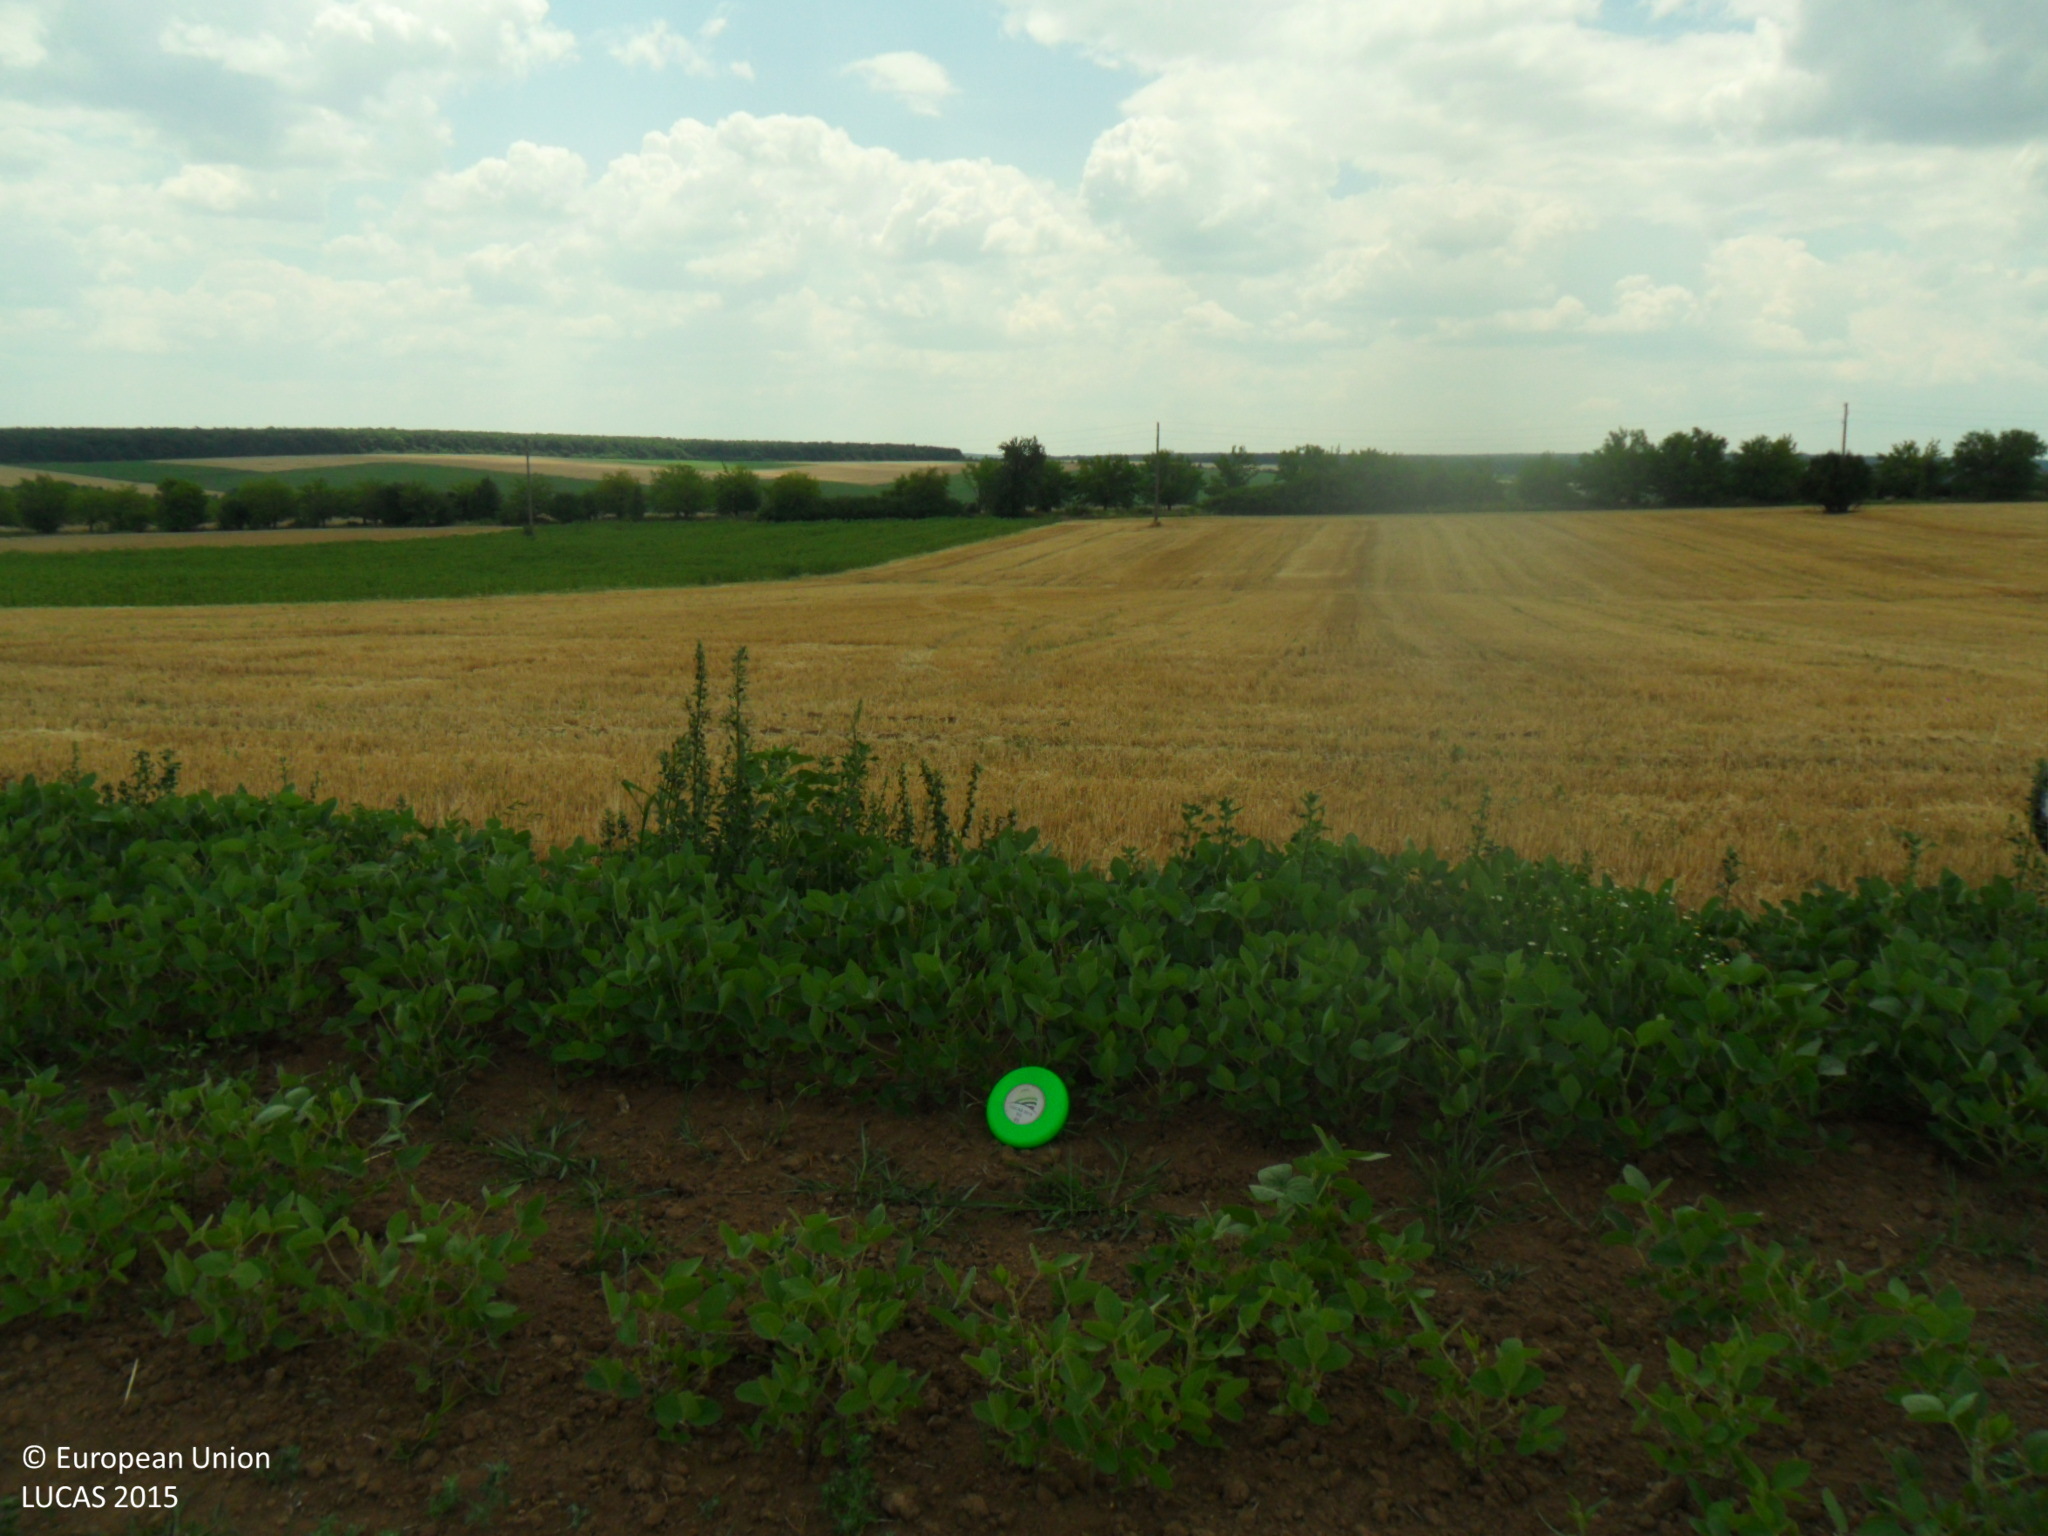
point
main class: Cropland
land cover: Soya
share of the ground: 50 - 75 %
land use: Agriculture (excluding fallow land and kitchen gardens)
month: July
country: BG
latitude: 43.6351
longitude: 26.8867
